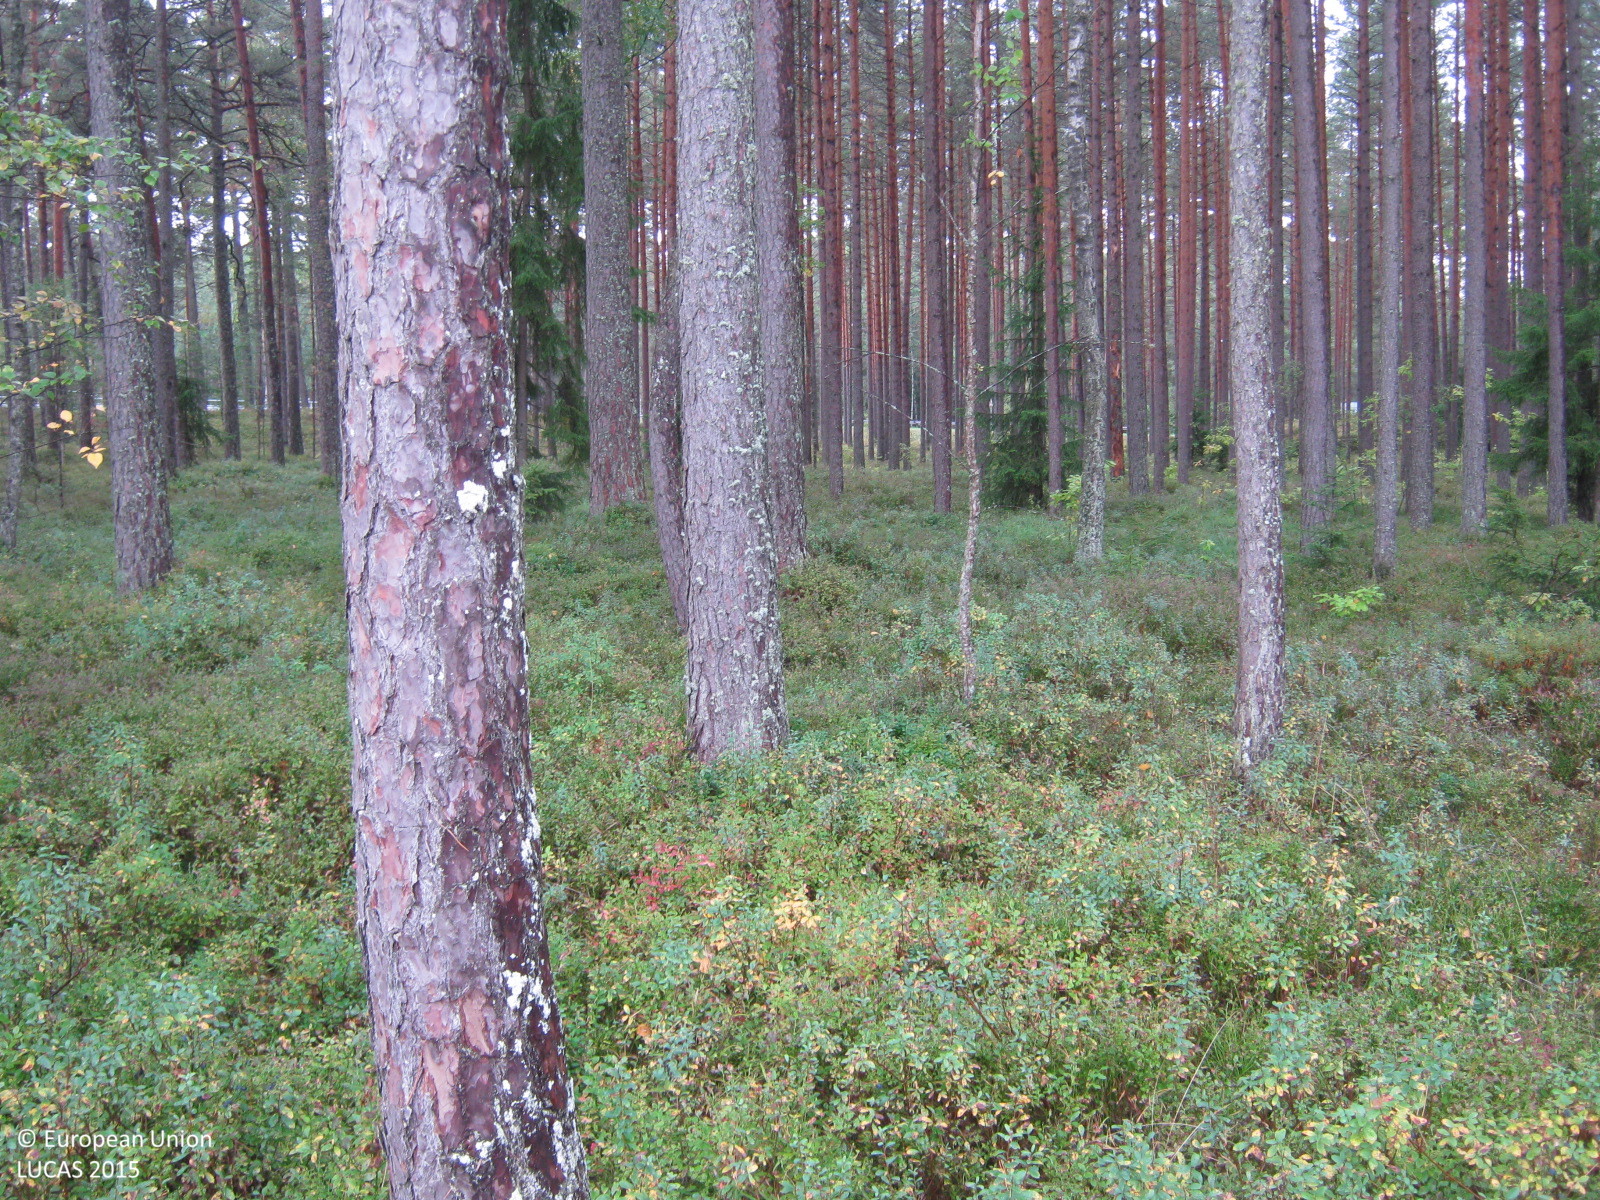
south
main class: Woodland
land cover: Pine dominated coniferous woodland
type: hemiboreal forest and nemoral coniferous forest and mixed broadleaved-coniferous forest
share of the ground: 50 - 75 %
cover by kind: coniferous forest trees 70 %, broadleaved forest trees 10 %, lichens and mosses 10 %, shrubs 5 %, herbaceous plants 5 %
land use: Forestry
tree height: > 5 m
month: September
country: LV
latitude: 57.2694
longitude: 24.4349
